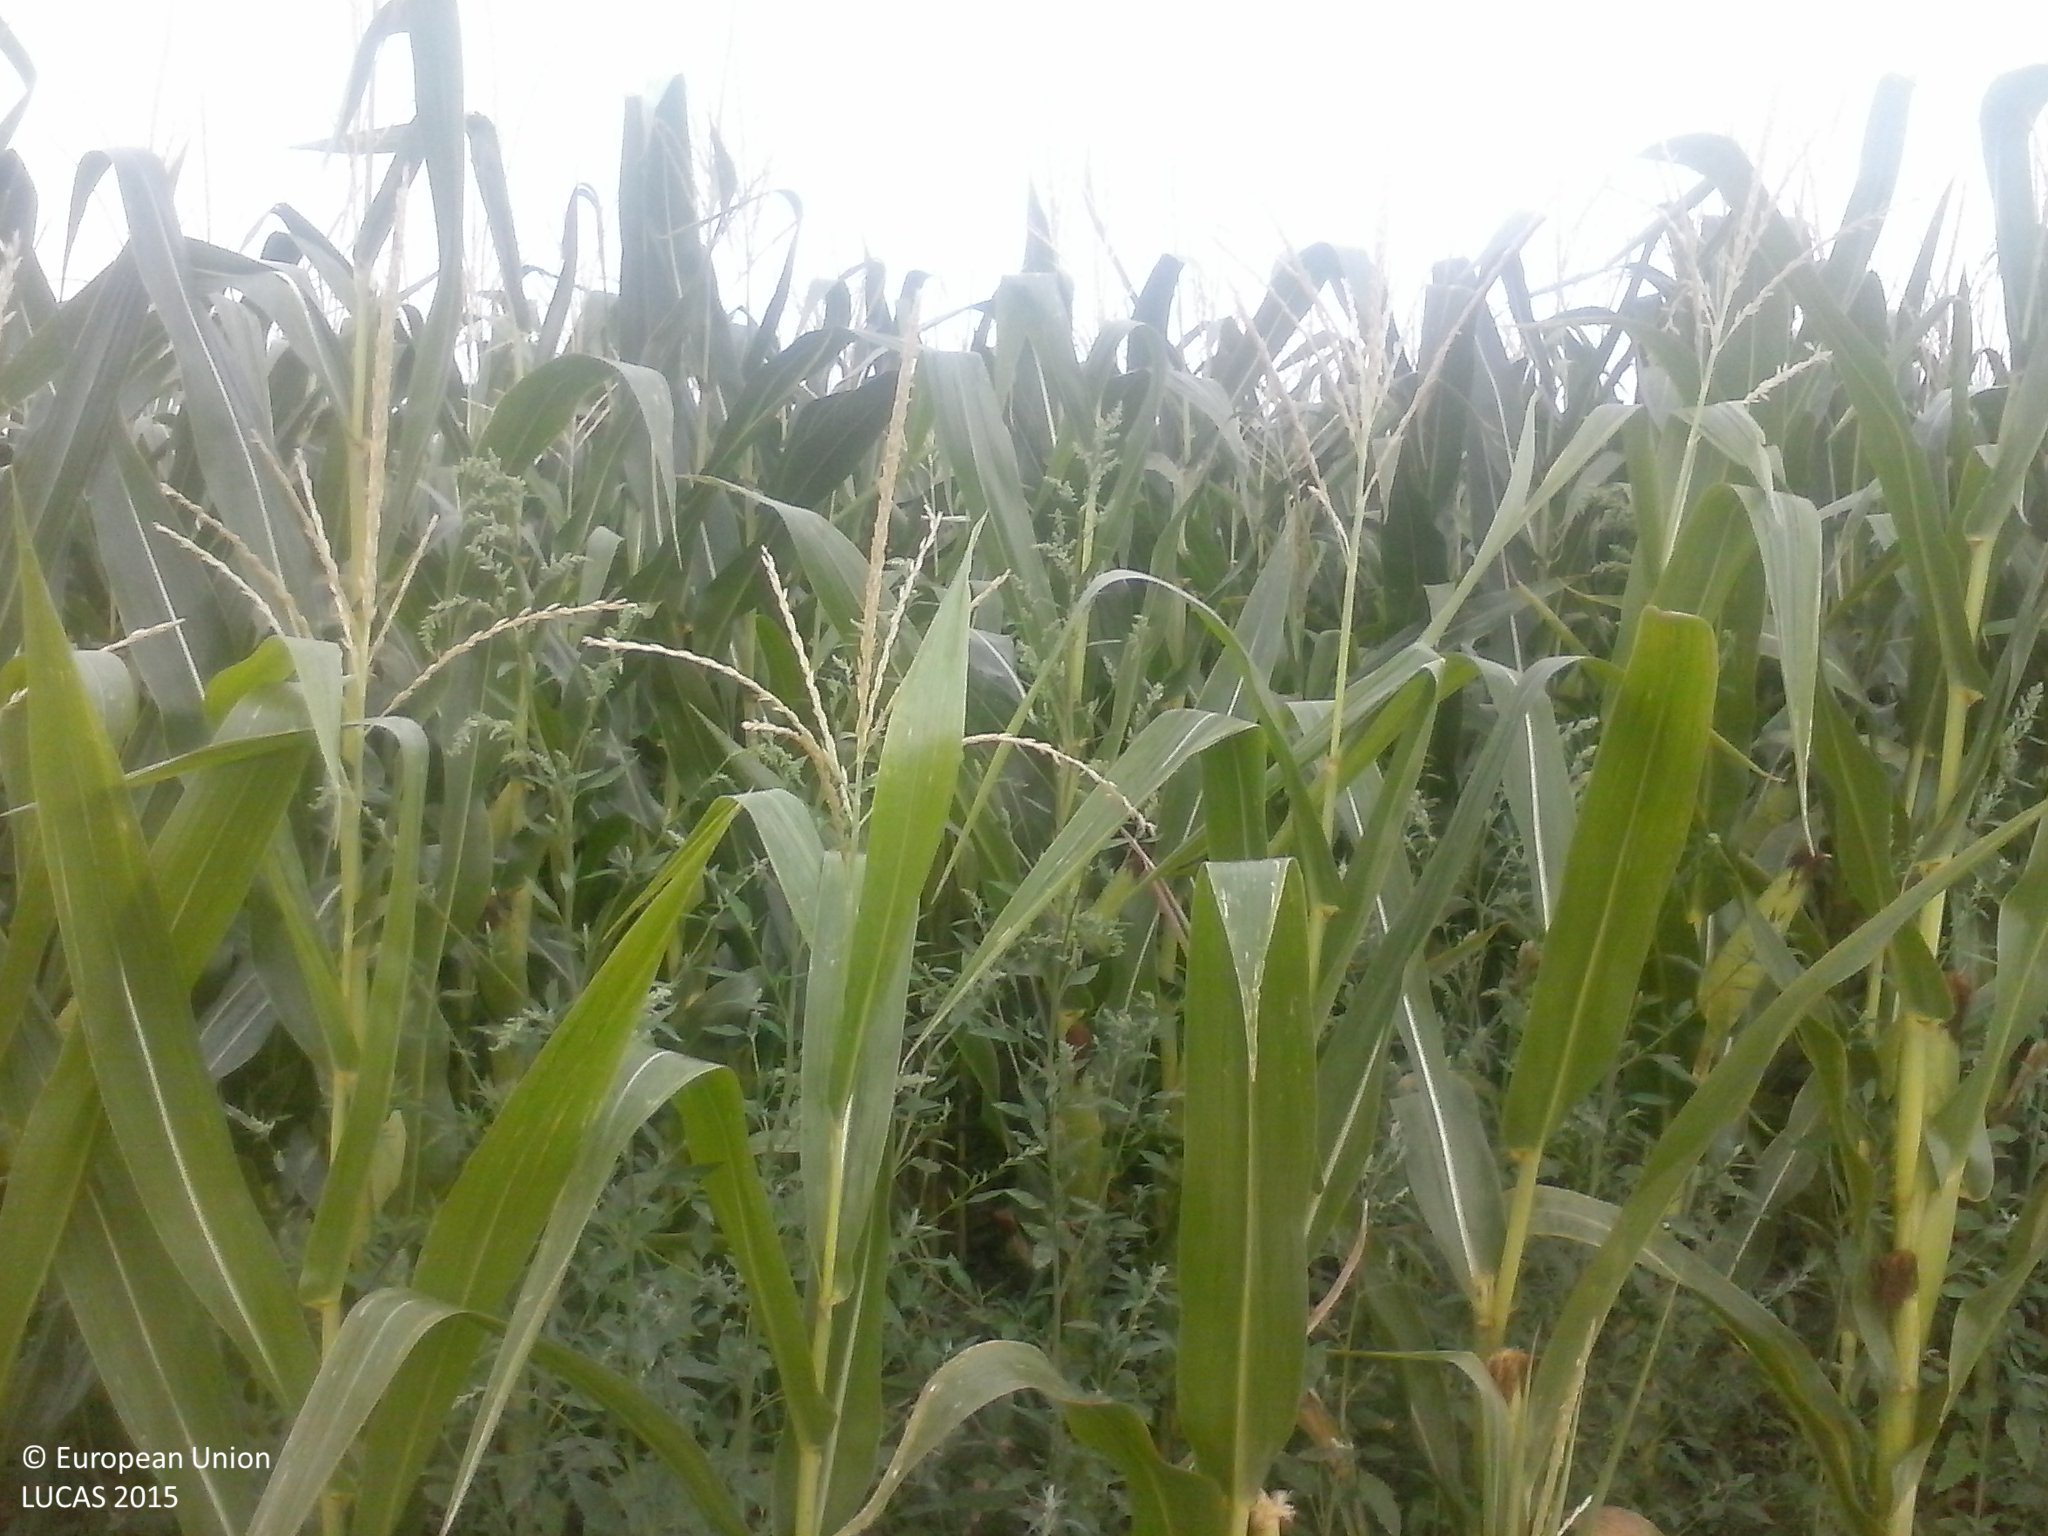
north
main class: Cropland
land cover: Maize
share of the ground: > 75 %
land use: Agriculture (excluding fallow land and kitchen gardens)
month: August
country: HU
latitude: 46.0111
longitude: 18.0520
